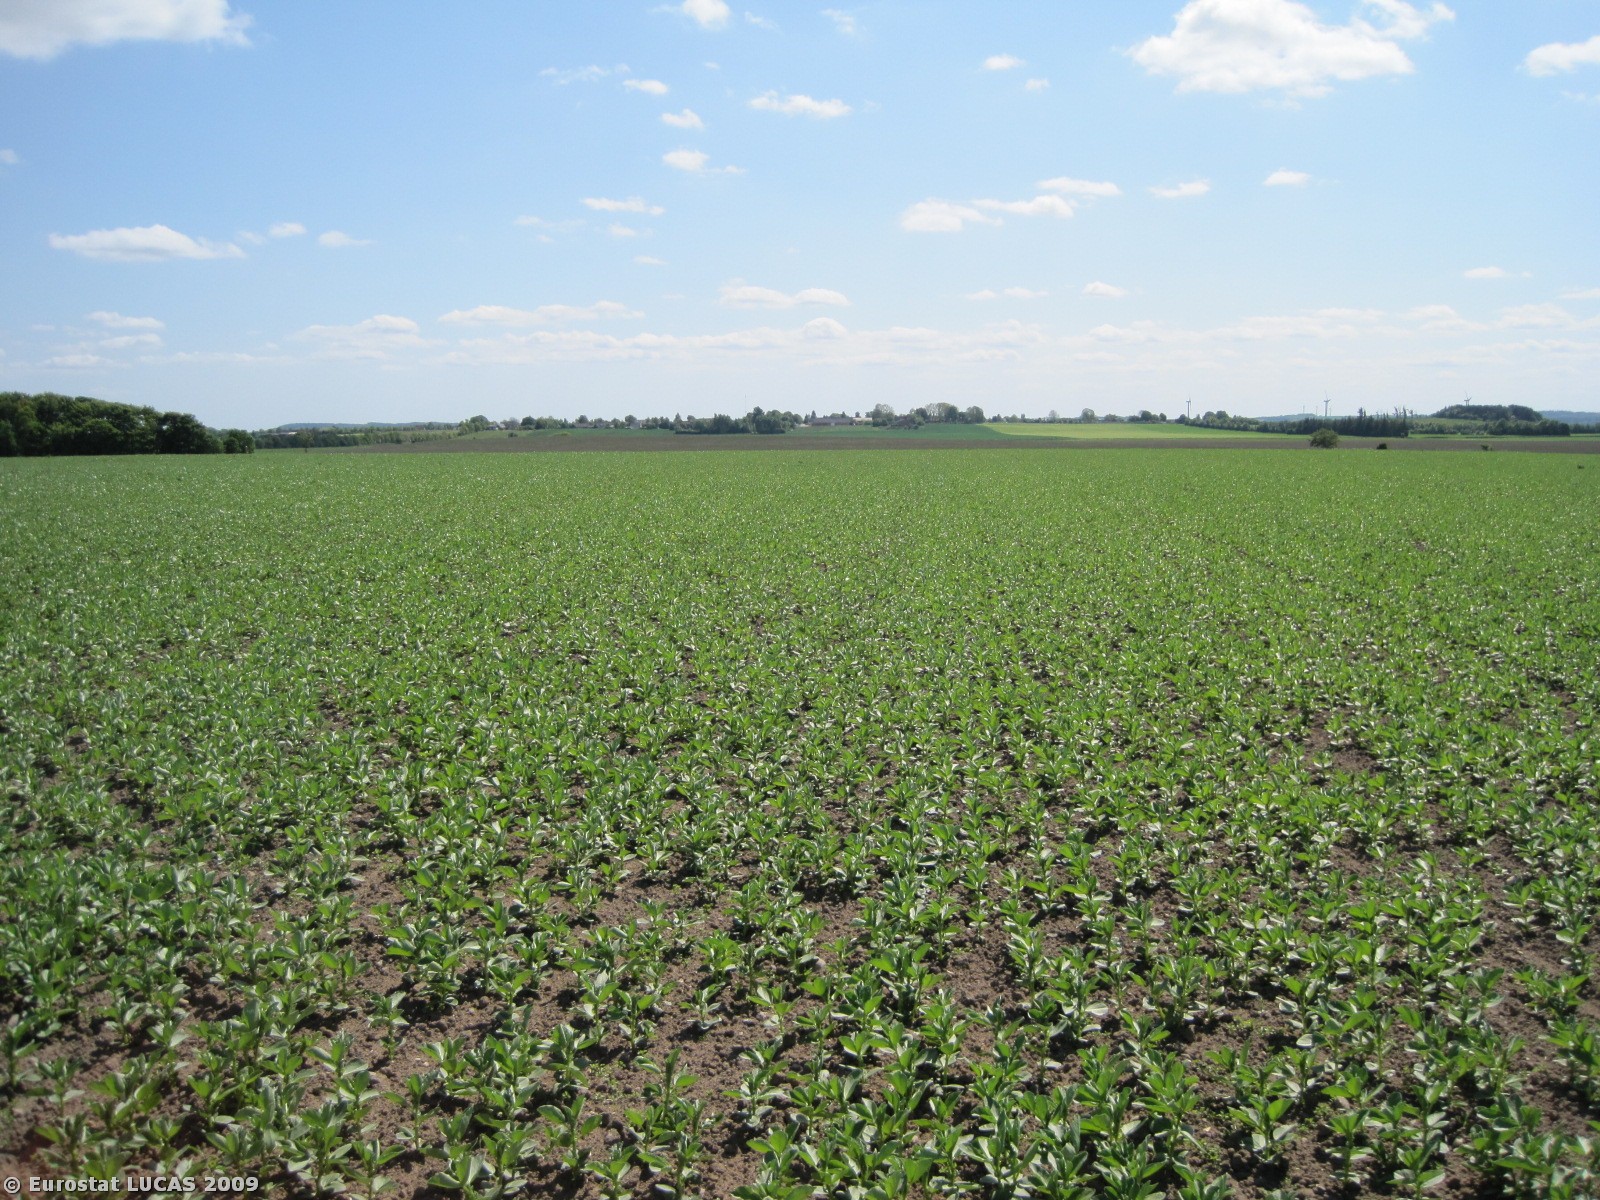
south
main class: Cropland
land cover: Dry pulses
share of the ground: 25 - 50 %
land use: Agriculture (excluding fallow land and kitchen gardens)
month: May
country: DK
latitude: 56.5110
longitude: 10.2759
